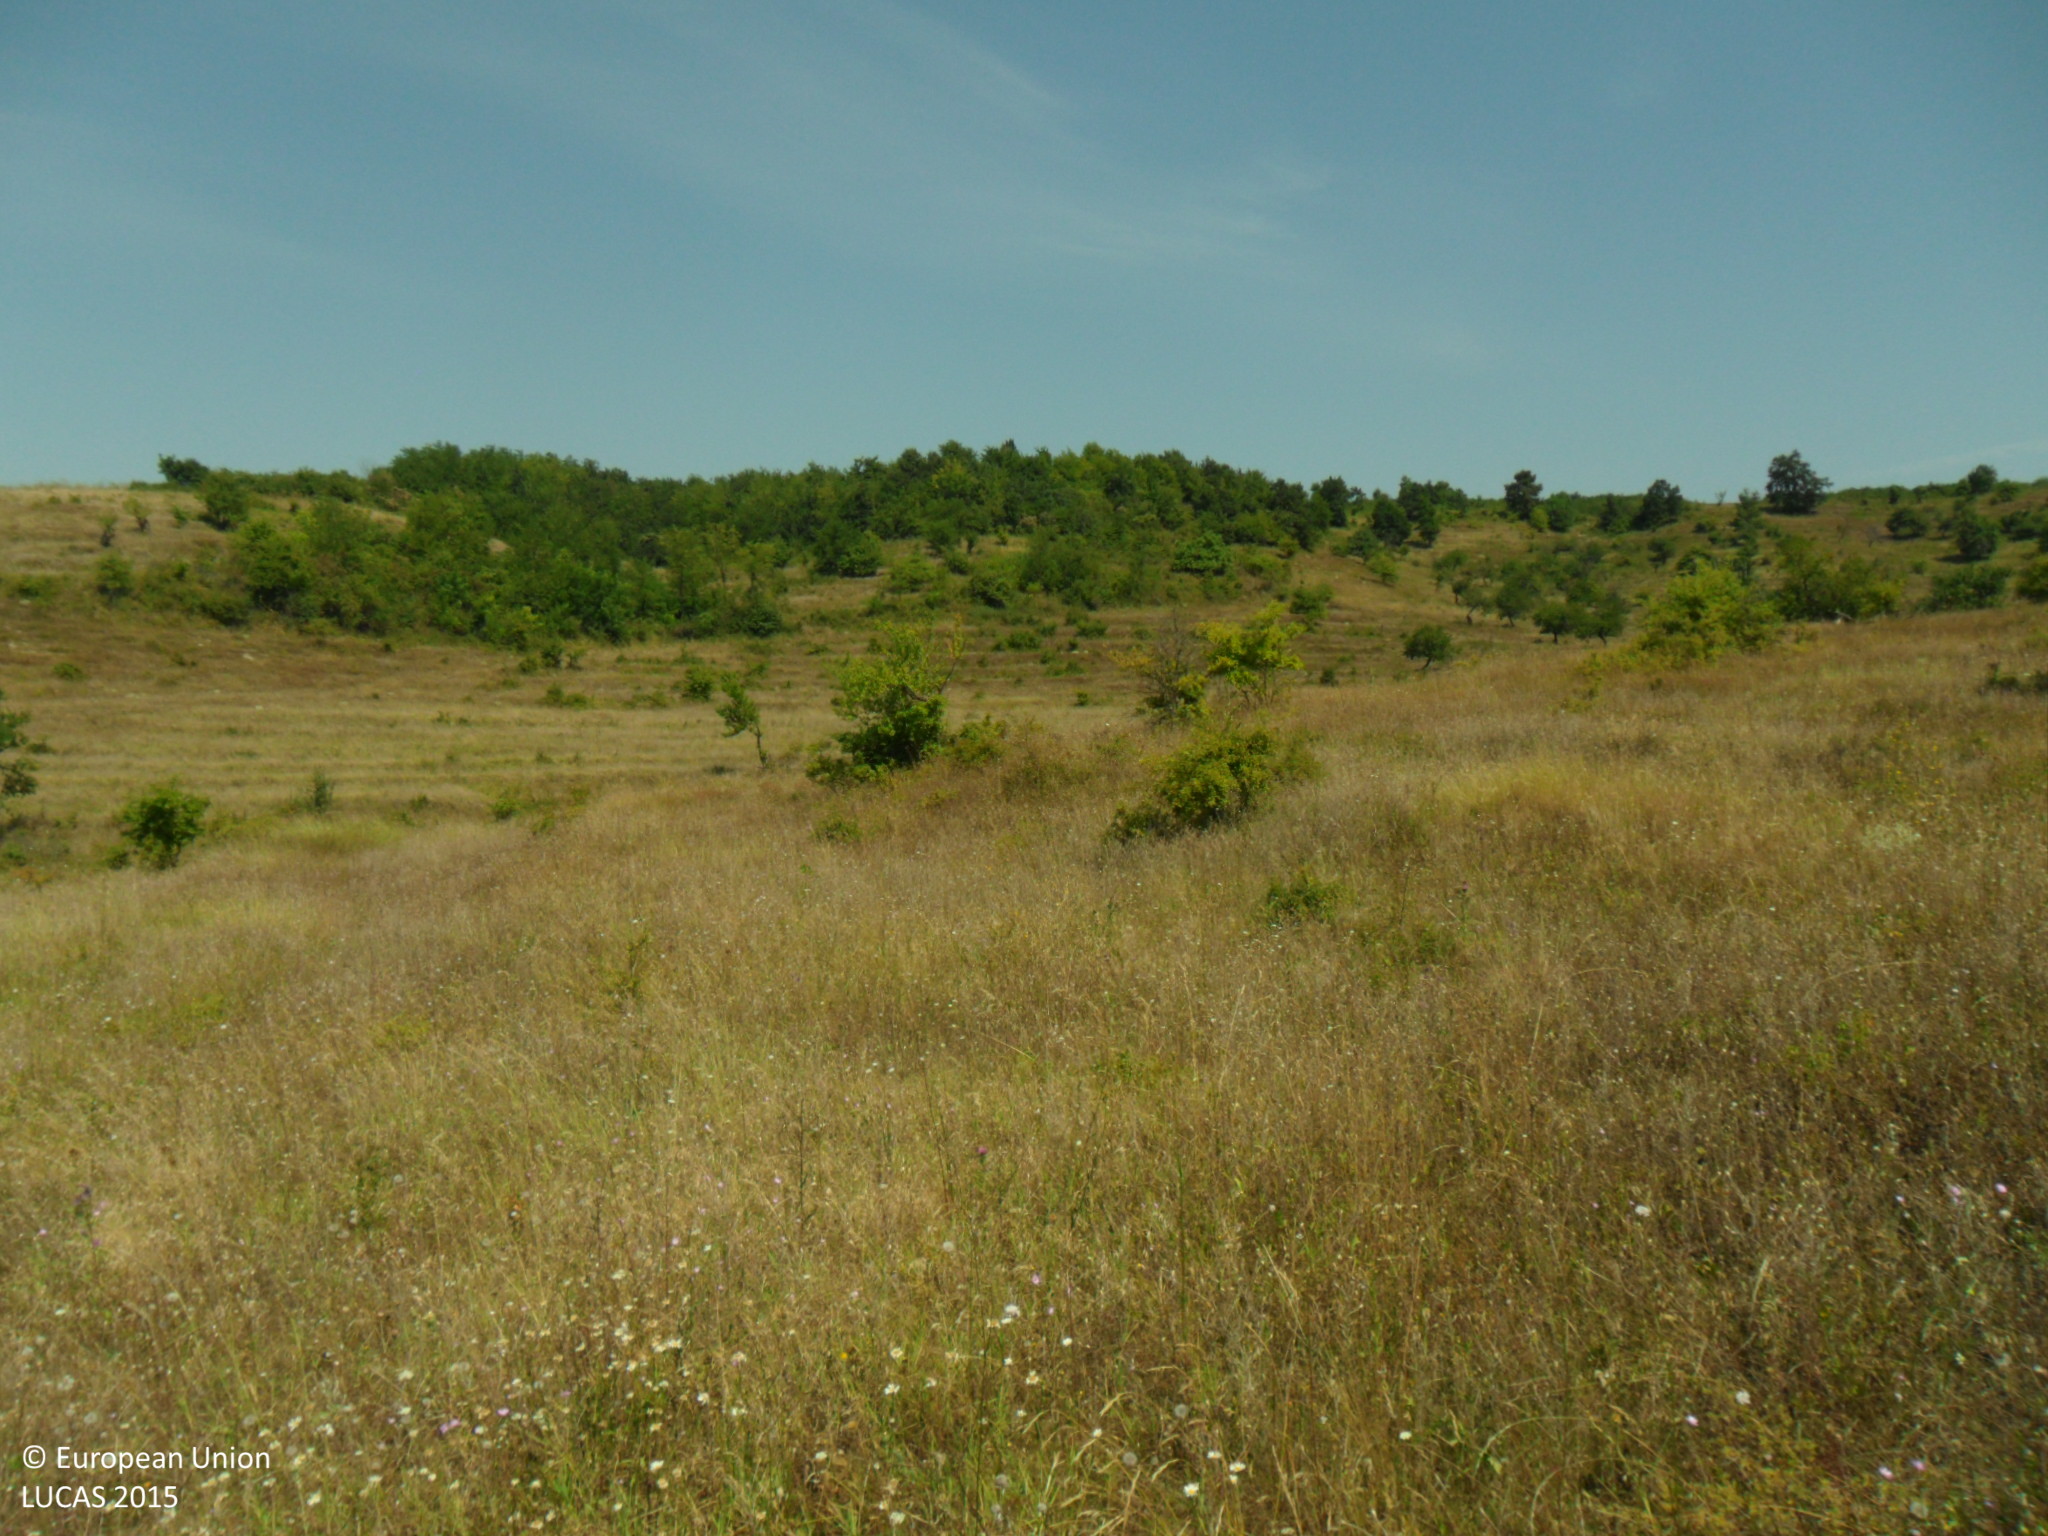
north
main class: Grassland
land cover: Grassland with sparse tree/shrub cover
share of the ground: > 75 %
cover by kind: herbaceous plants 90 %, broadleaved forest trees 5 %, shrubs 5 %
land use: Agriculture (excluding fallow land and kitchen gardens)
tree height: < 5 m
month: August
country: BG
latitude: 43.4623
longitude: 26.7086
